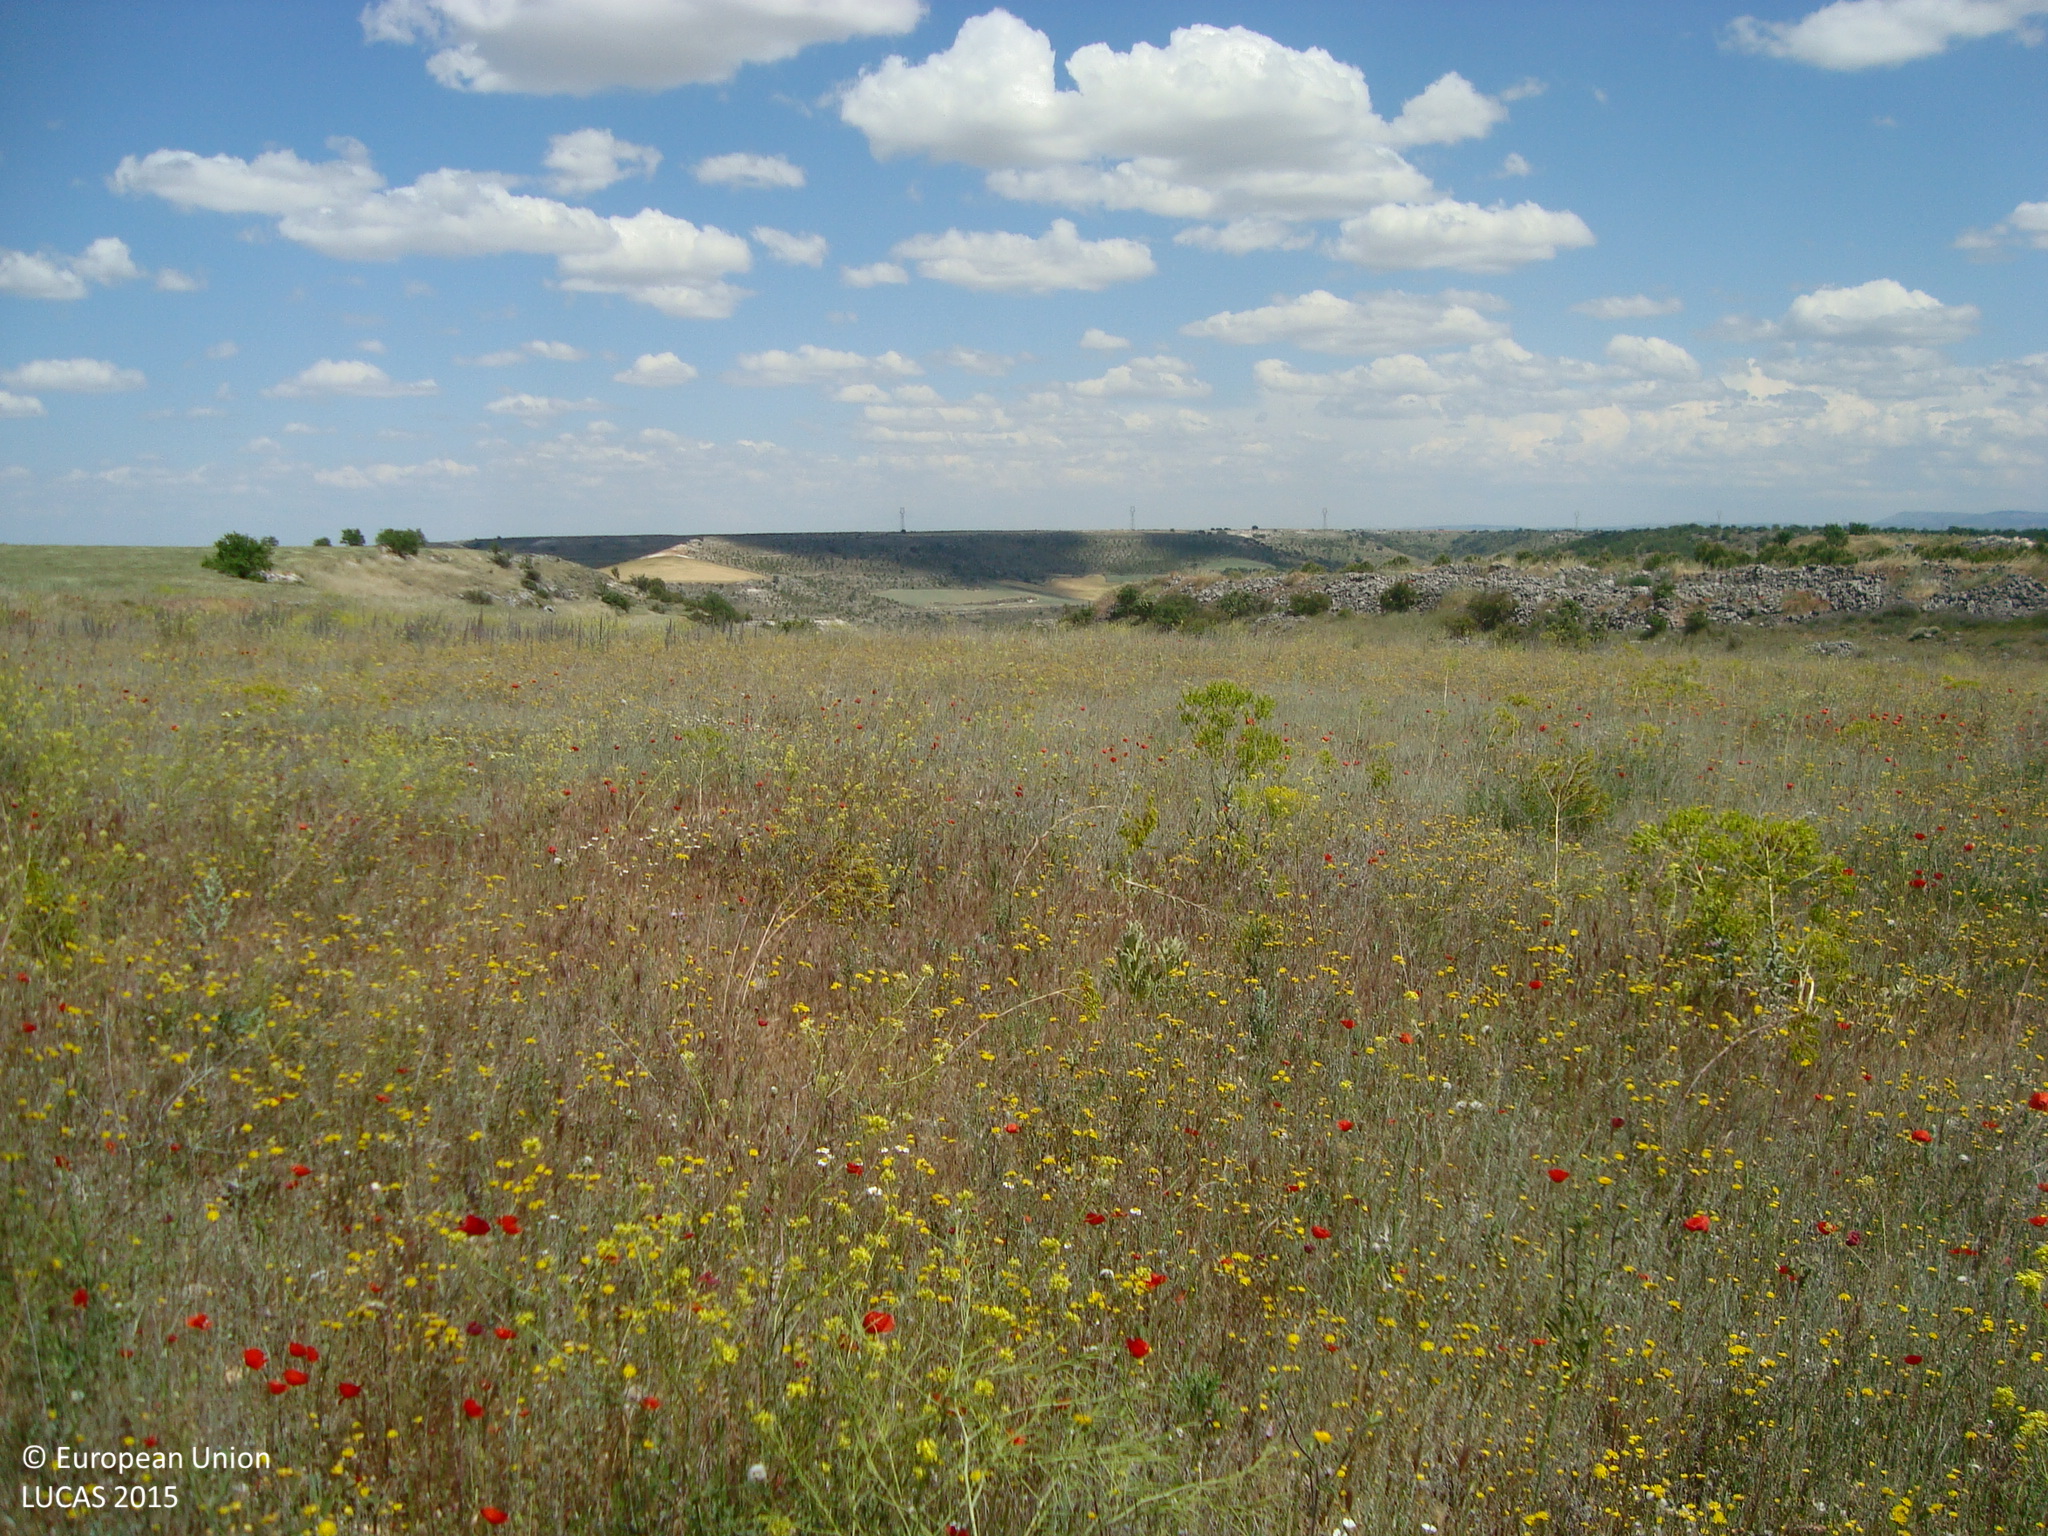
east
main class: Grassland
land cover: Grassland without tree/shrub cover
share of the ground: > 75 %
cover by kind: herbaceous plants 95 %, unconsolidated bare surface 5 %
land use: Abandoned areas
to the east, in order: Grassland without tree/shrub cover; Grassland with sparse tree/shrub cover; Tracks; Grassland with sparse tree/shrub cover; Common wheat
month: May
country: ES
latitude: 41.5594
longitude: -4.0497
